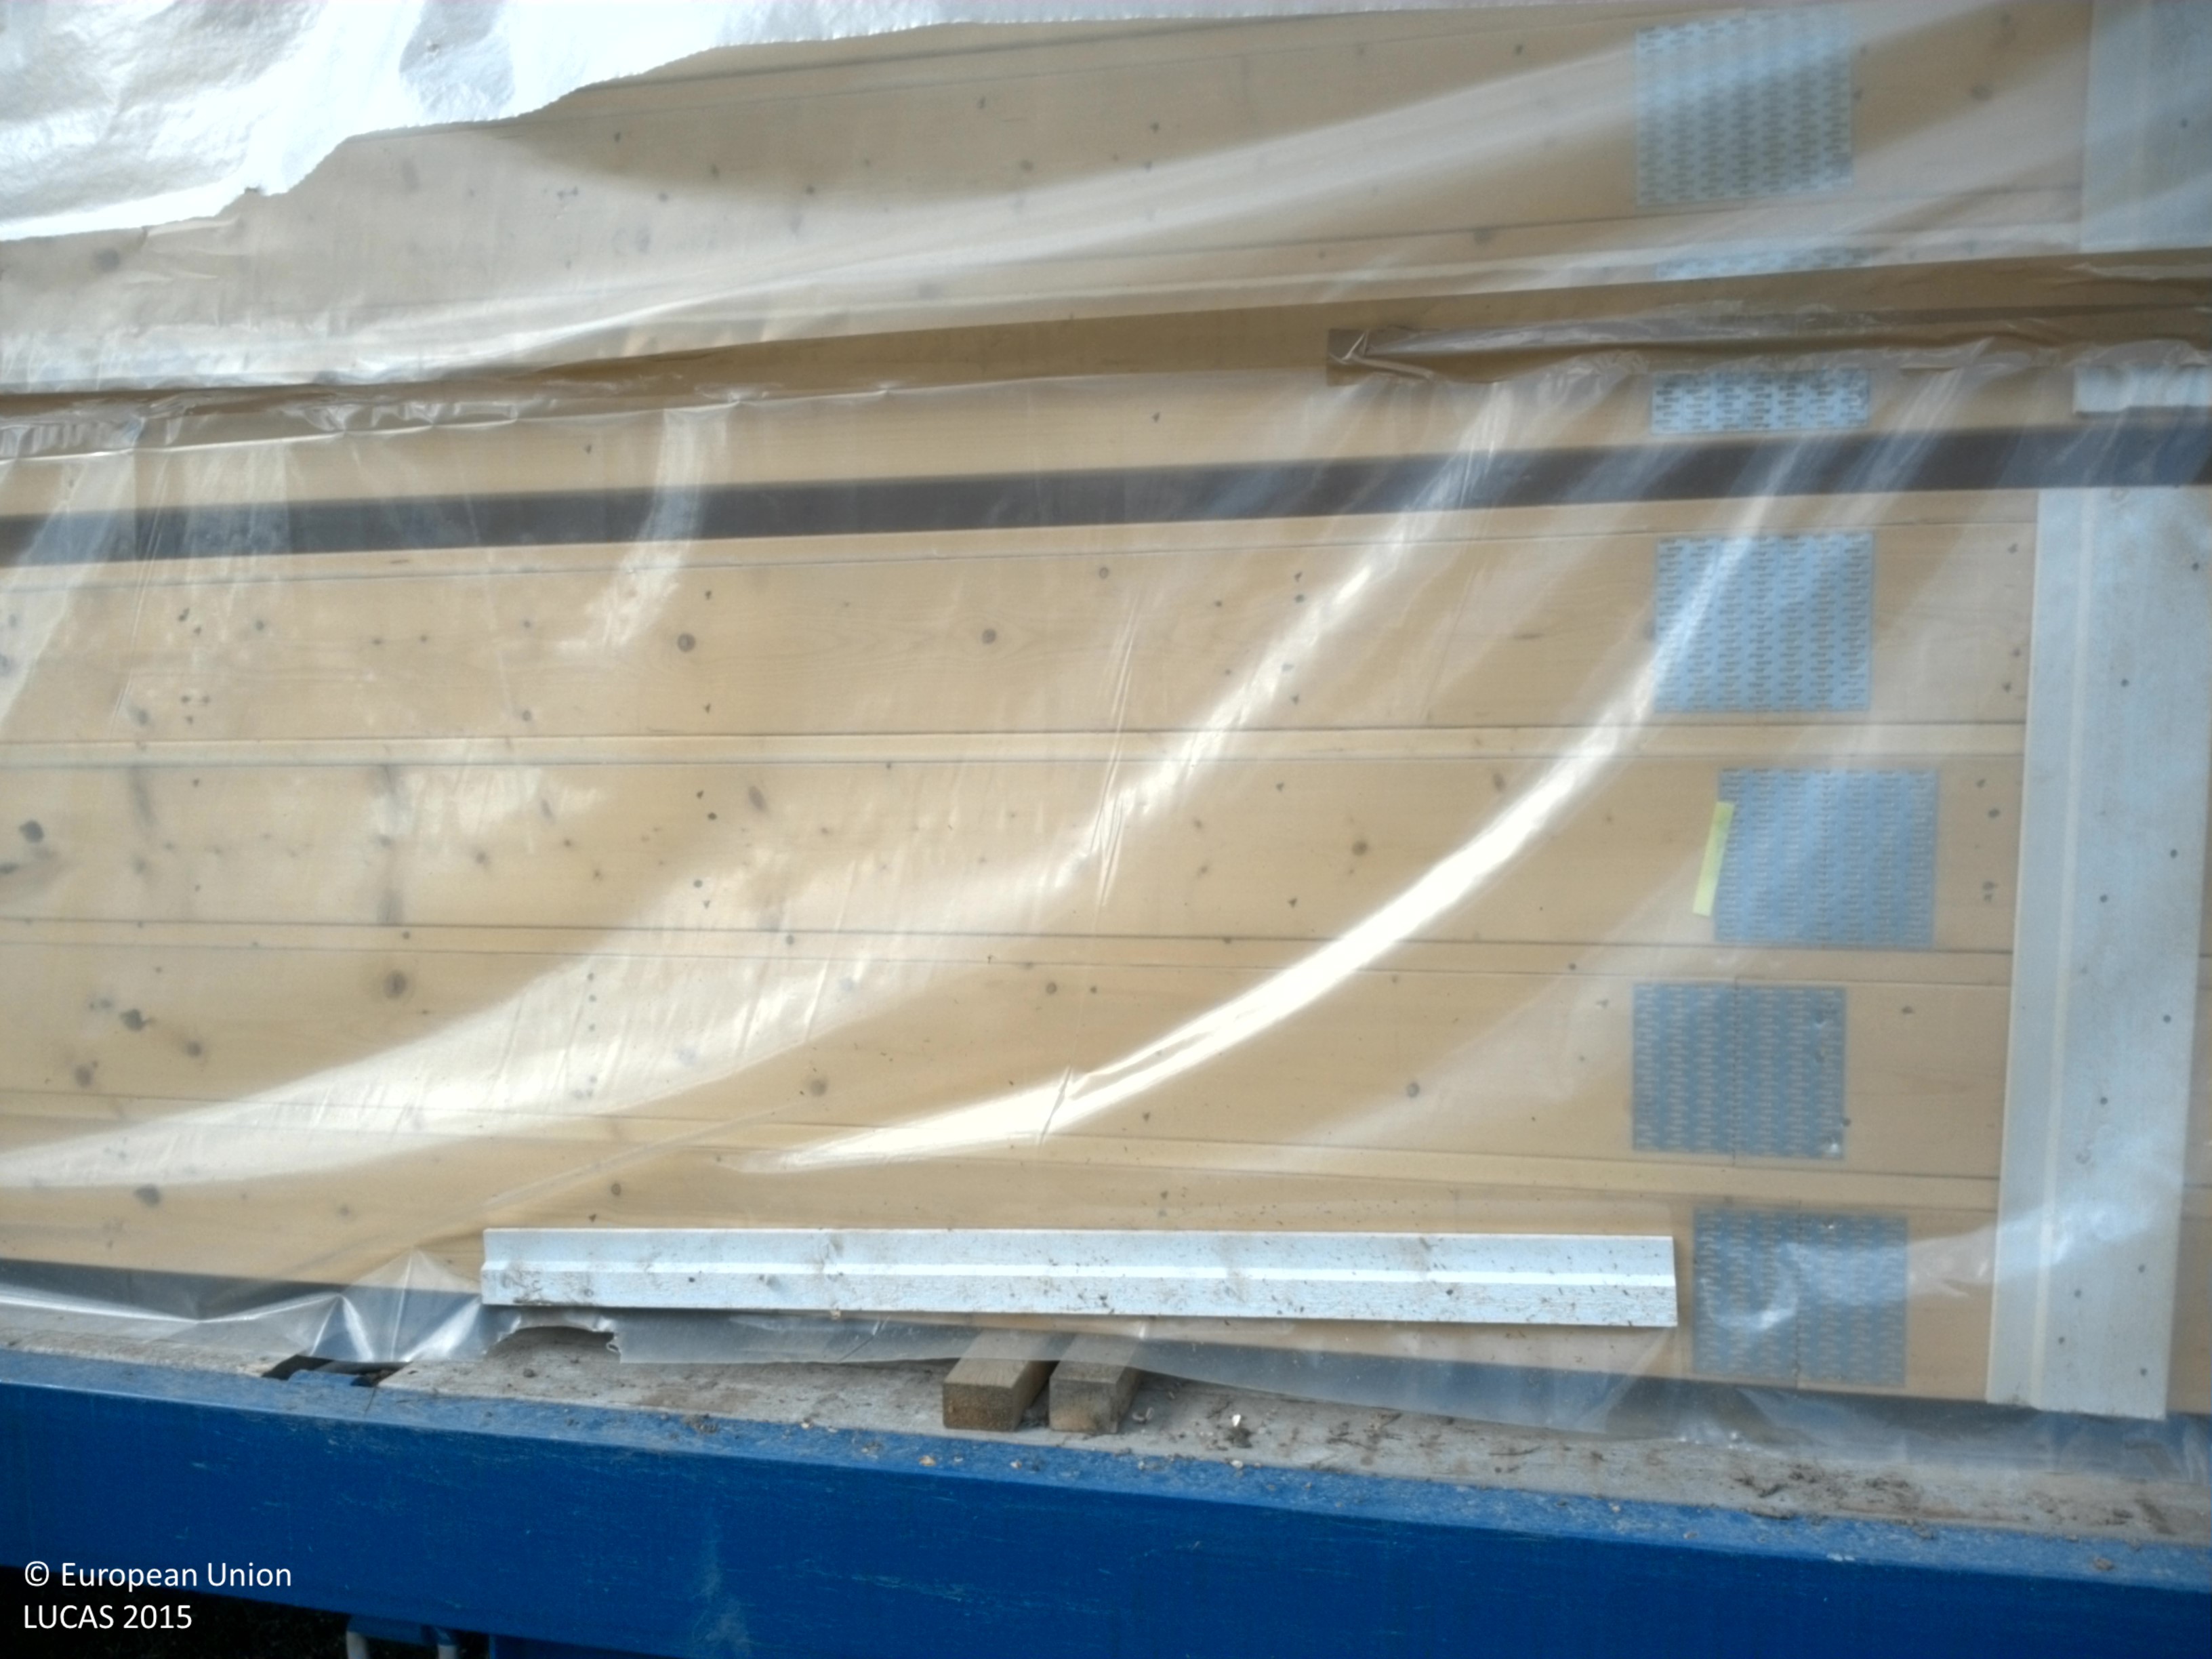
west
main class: Grassland
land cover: Grassland without tree/shrub cover
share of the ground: > 75 %
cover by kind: herbaceous plants 100 %
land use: Residential
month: August
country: SE
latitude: 59.6895
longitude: 17.8655
